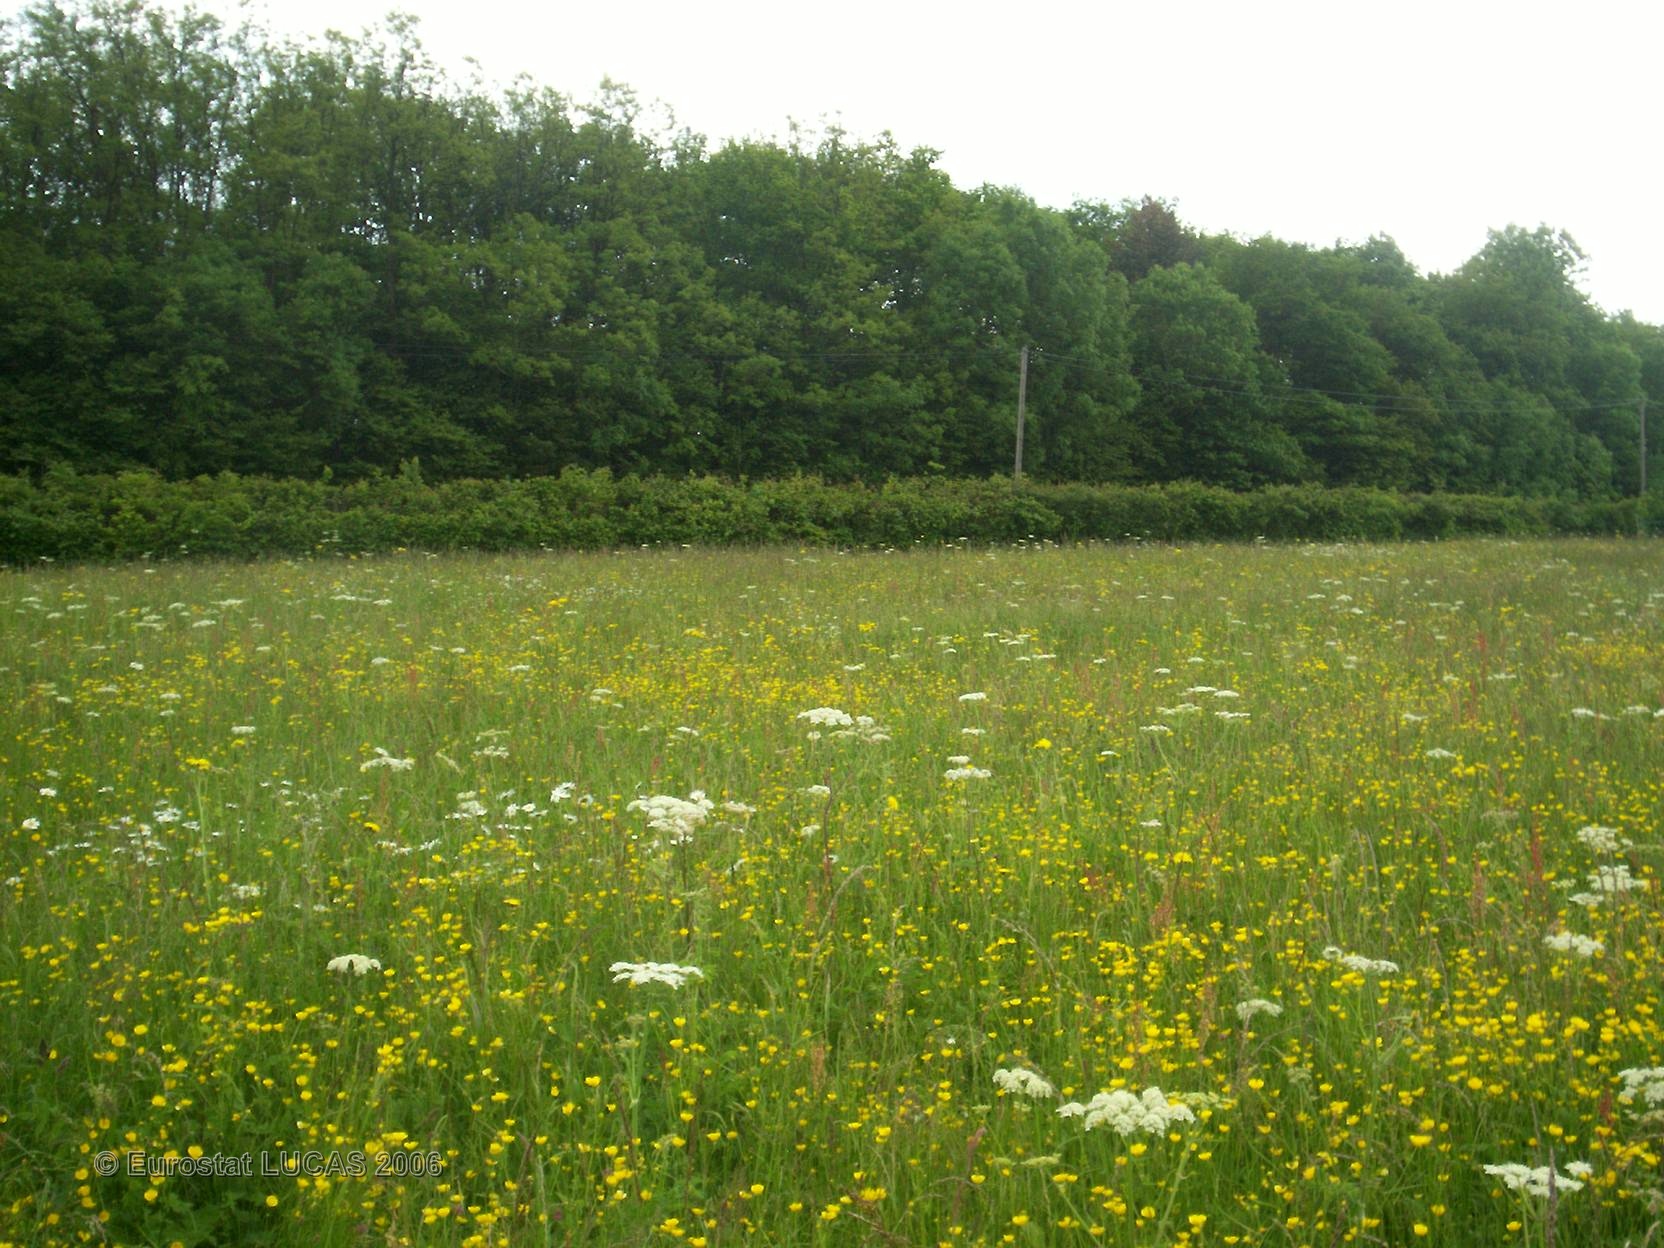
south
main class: Grassland
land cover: Grassland without tree/shrub cover
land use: Agriculture (excluding fallow land and kitchen gardens)
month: June
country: FR
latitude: 47.0702
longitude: 4.7463
